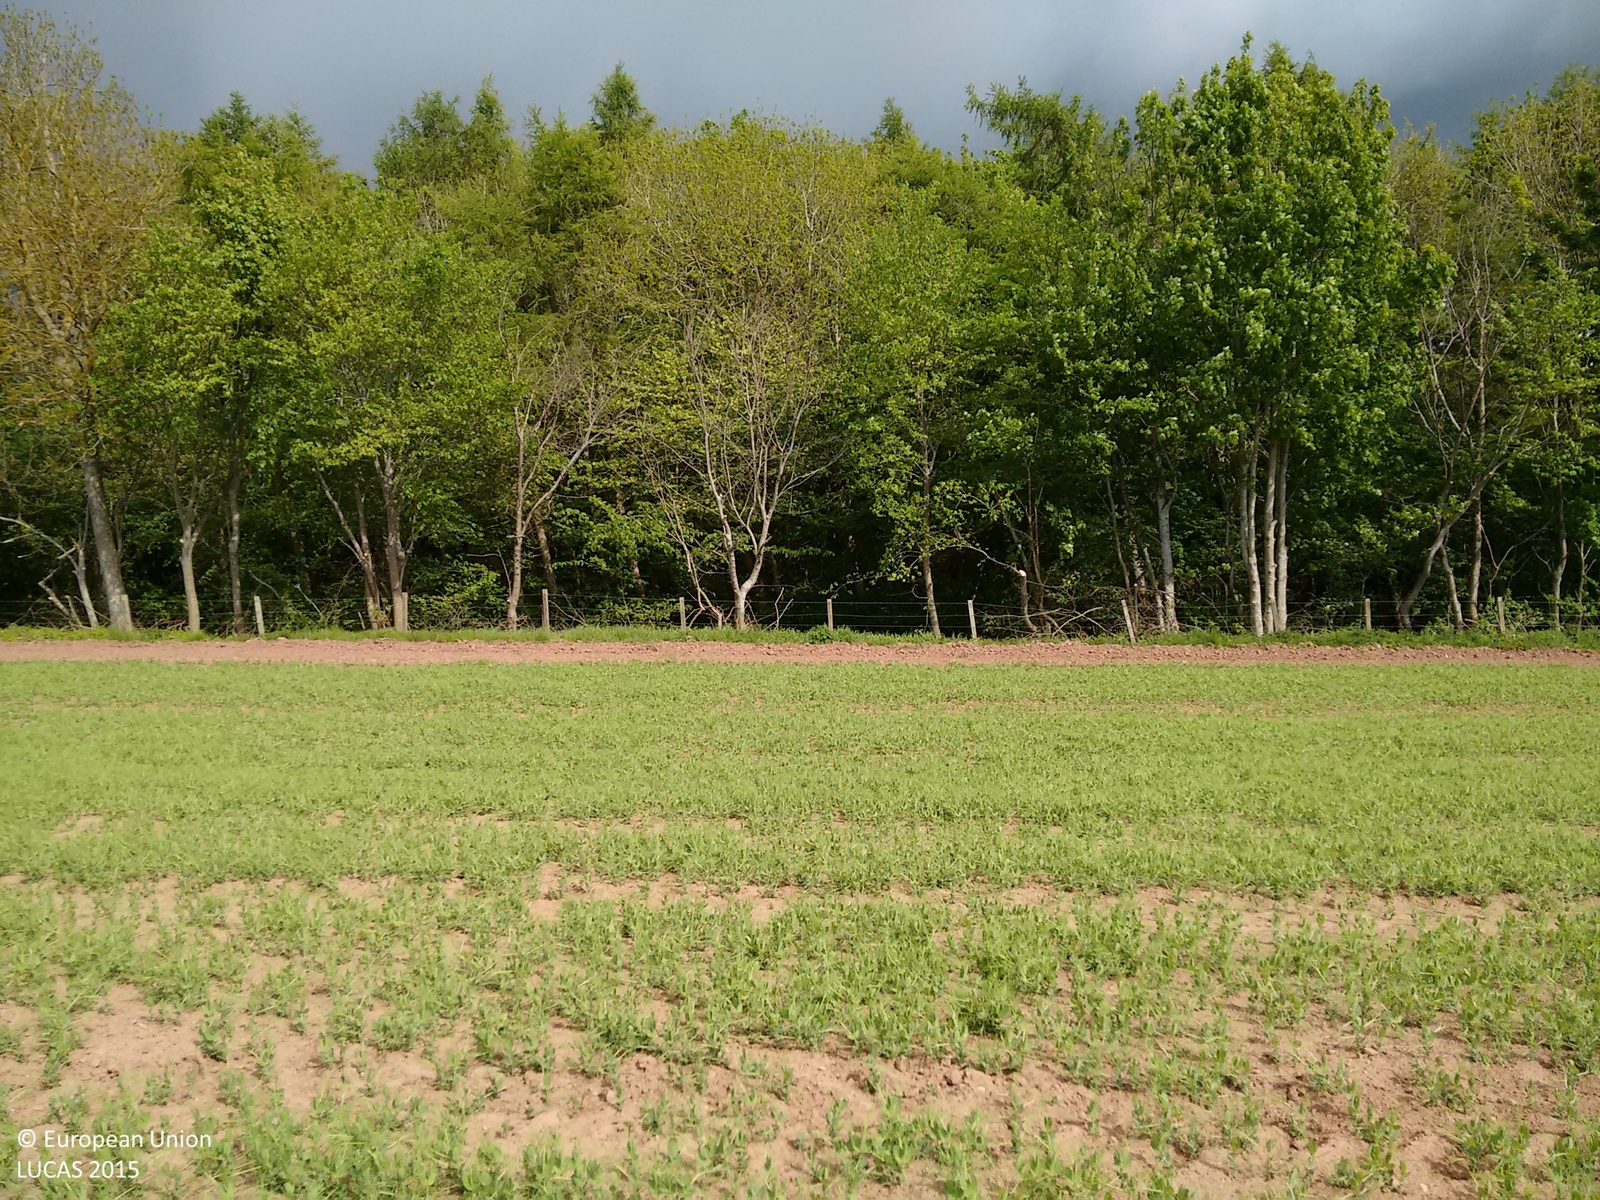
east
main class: Cropland
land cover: Dry pulses
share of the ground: 25 - 50 %
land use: Agriculture (excluding fallow land and kitchen gardens)
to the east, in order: Dry pulses; Grass margins; Fences; Lines of trees; Grass margins; Paved roads, cycling and walking lanes; Grass margins; Fences; Other mixed woodland; Rivers and streams; Other mixed woodland; Fences; Barley
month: May
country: GB
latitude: 55.5433
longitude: -2.4372
